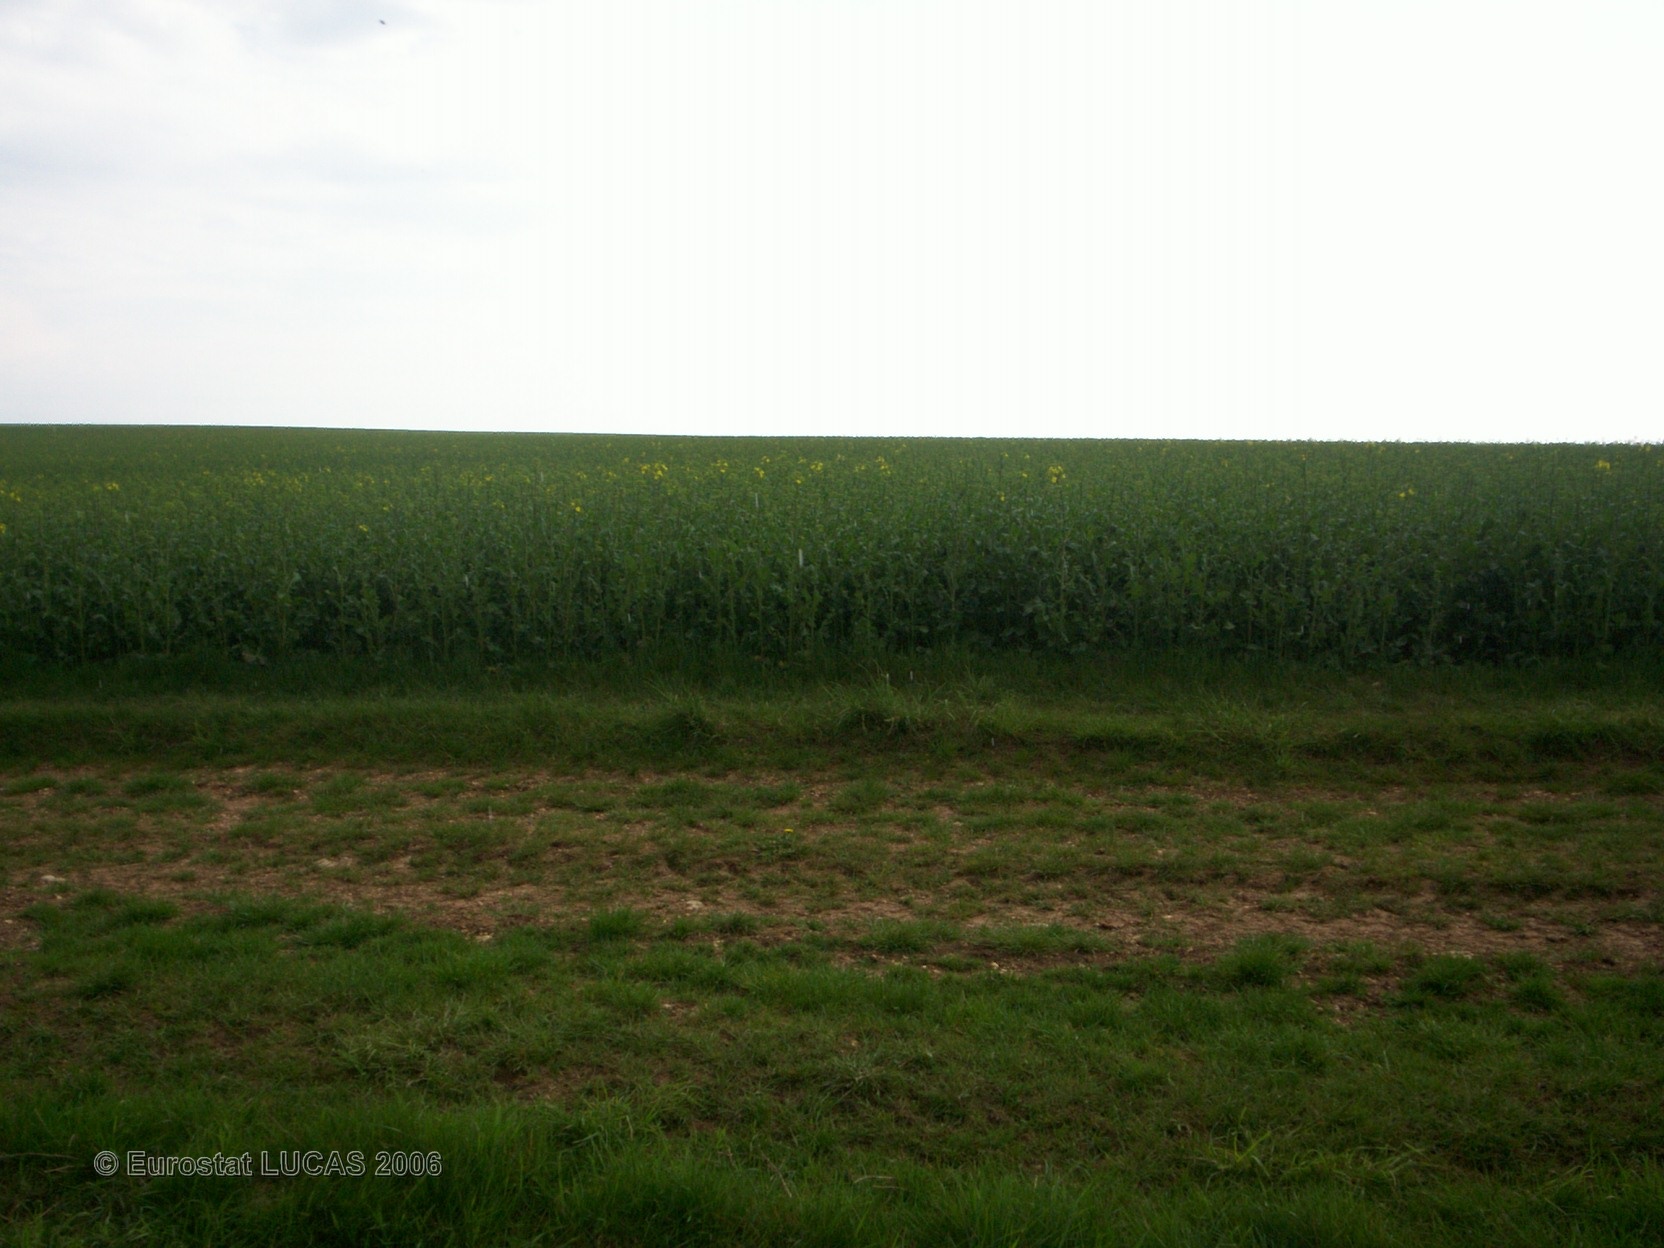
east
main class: Cropland
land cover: Barley
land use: Agriculture (excluding fallow land and kitchen gardens)
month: April
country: FR
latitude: 47.3910
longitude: 3.0662
